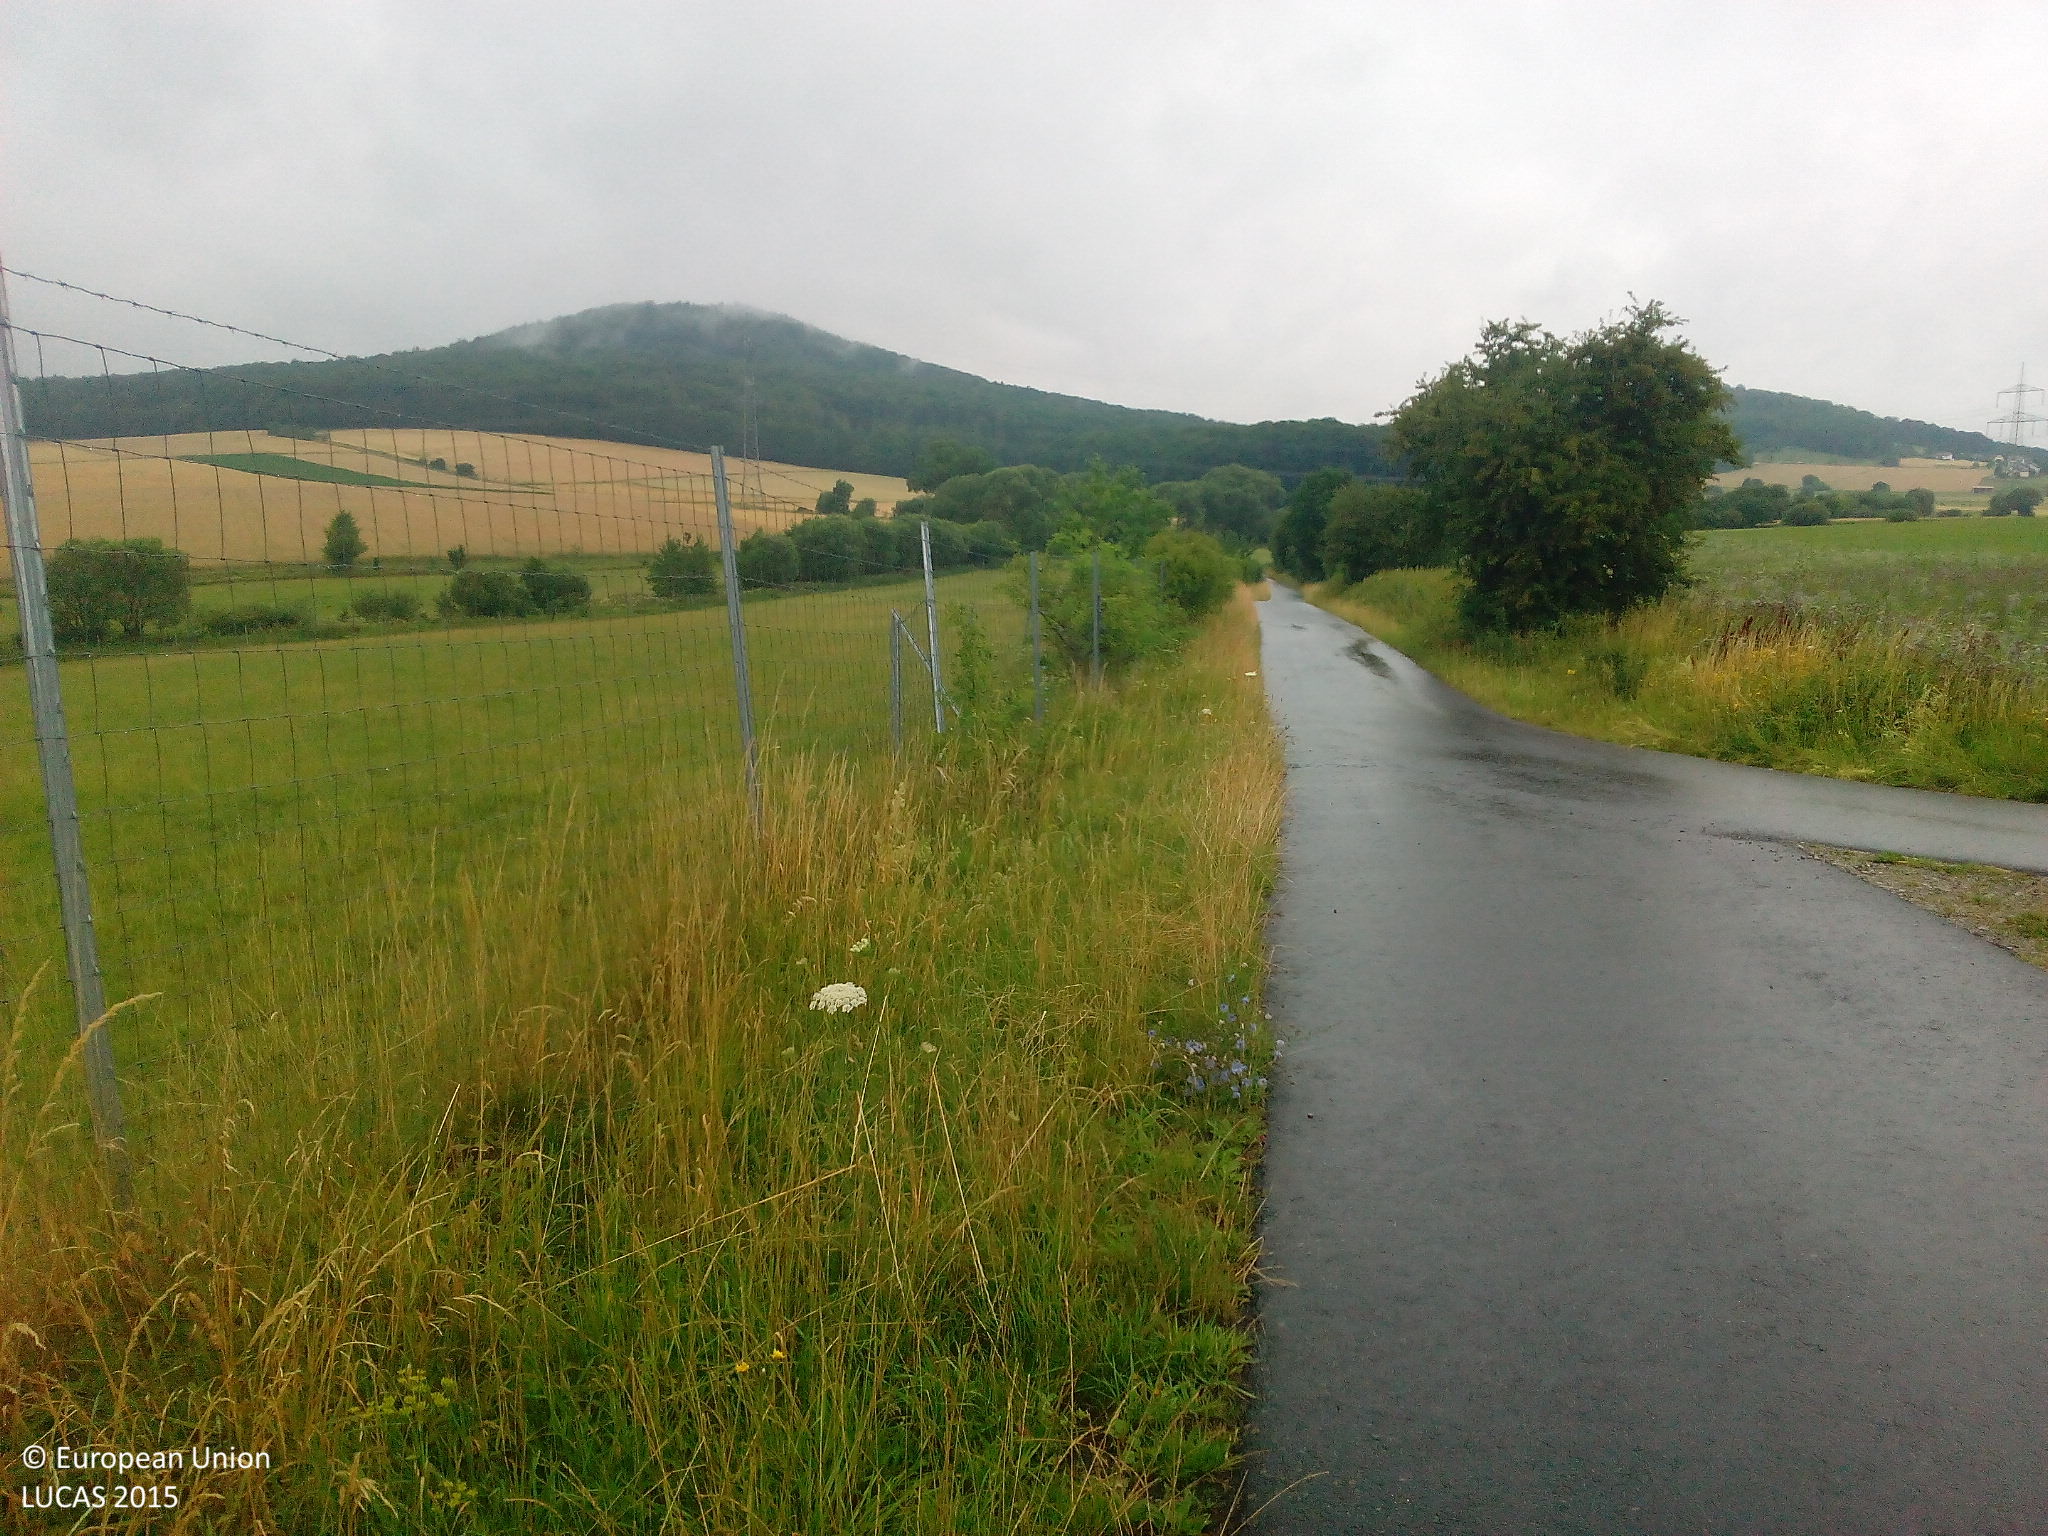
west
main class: Grassland
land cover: Grassland without tree/shrub cover
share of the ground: > 75 %
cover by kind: herbaceous plants 100 %
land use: Agriculture (excluding fallow land and kitchen gardens)
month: July
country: DE
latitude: 50.7415
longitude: 9.8442
